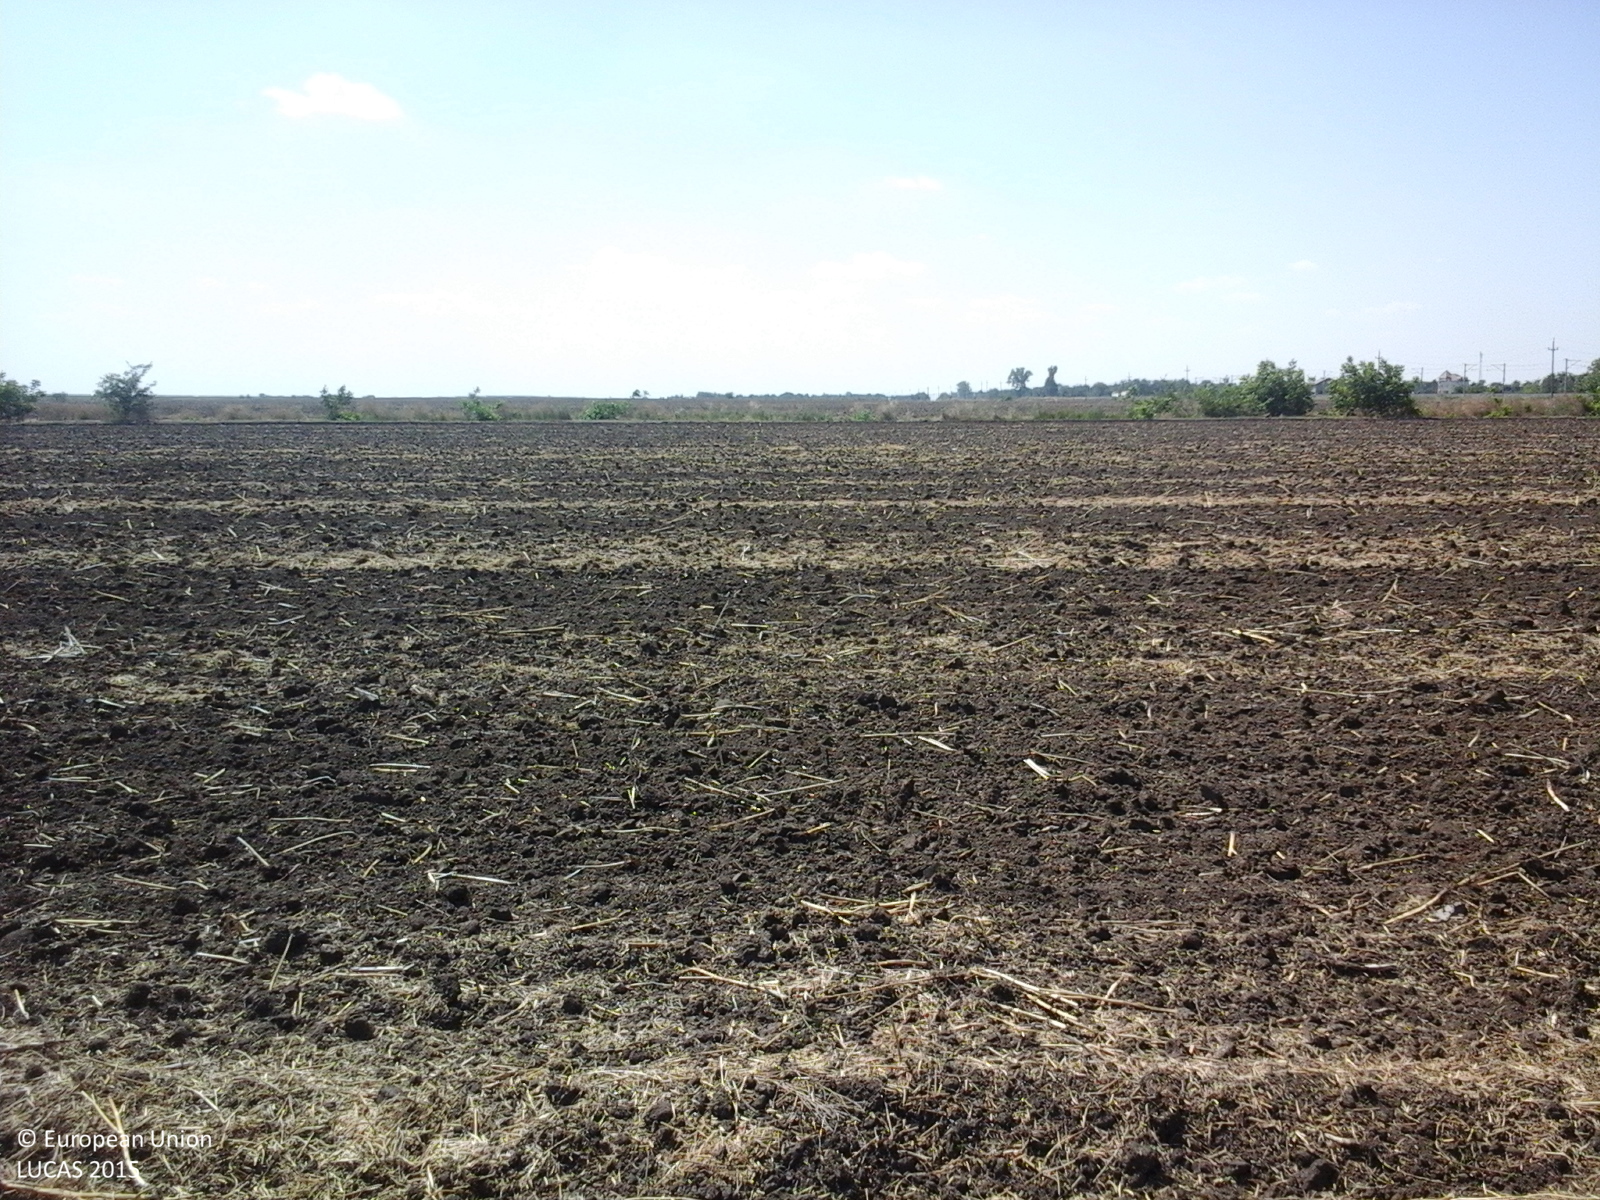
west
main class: Cropland
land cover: Rape and turnip rape
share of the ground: < 10 %
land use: Agriculture (excluding fallow land and kitchen gardens)
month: July
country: RO
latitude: 44.4313
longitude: 27.0767
